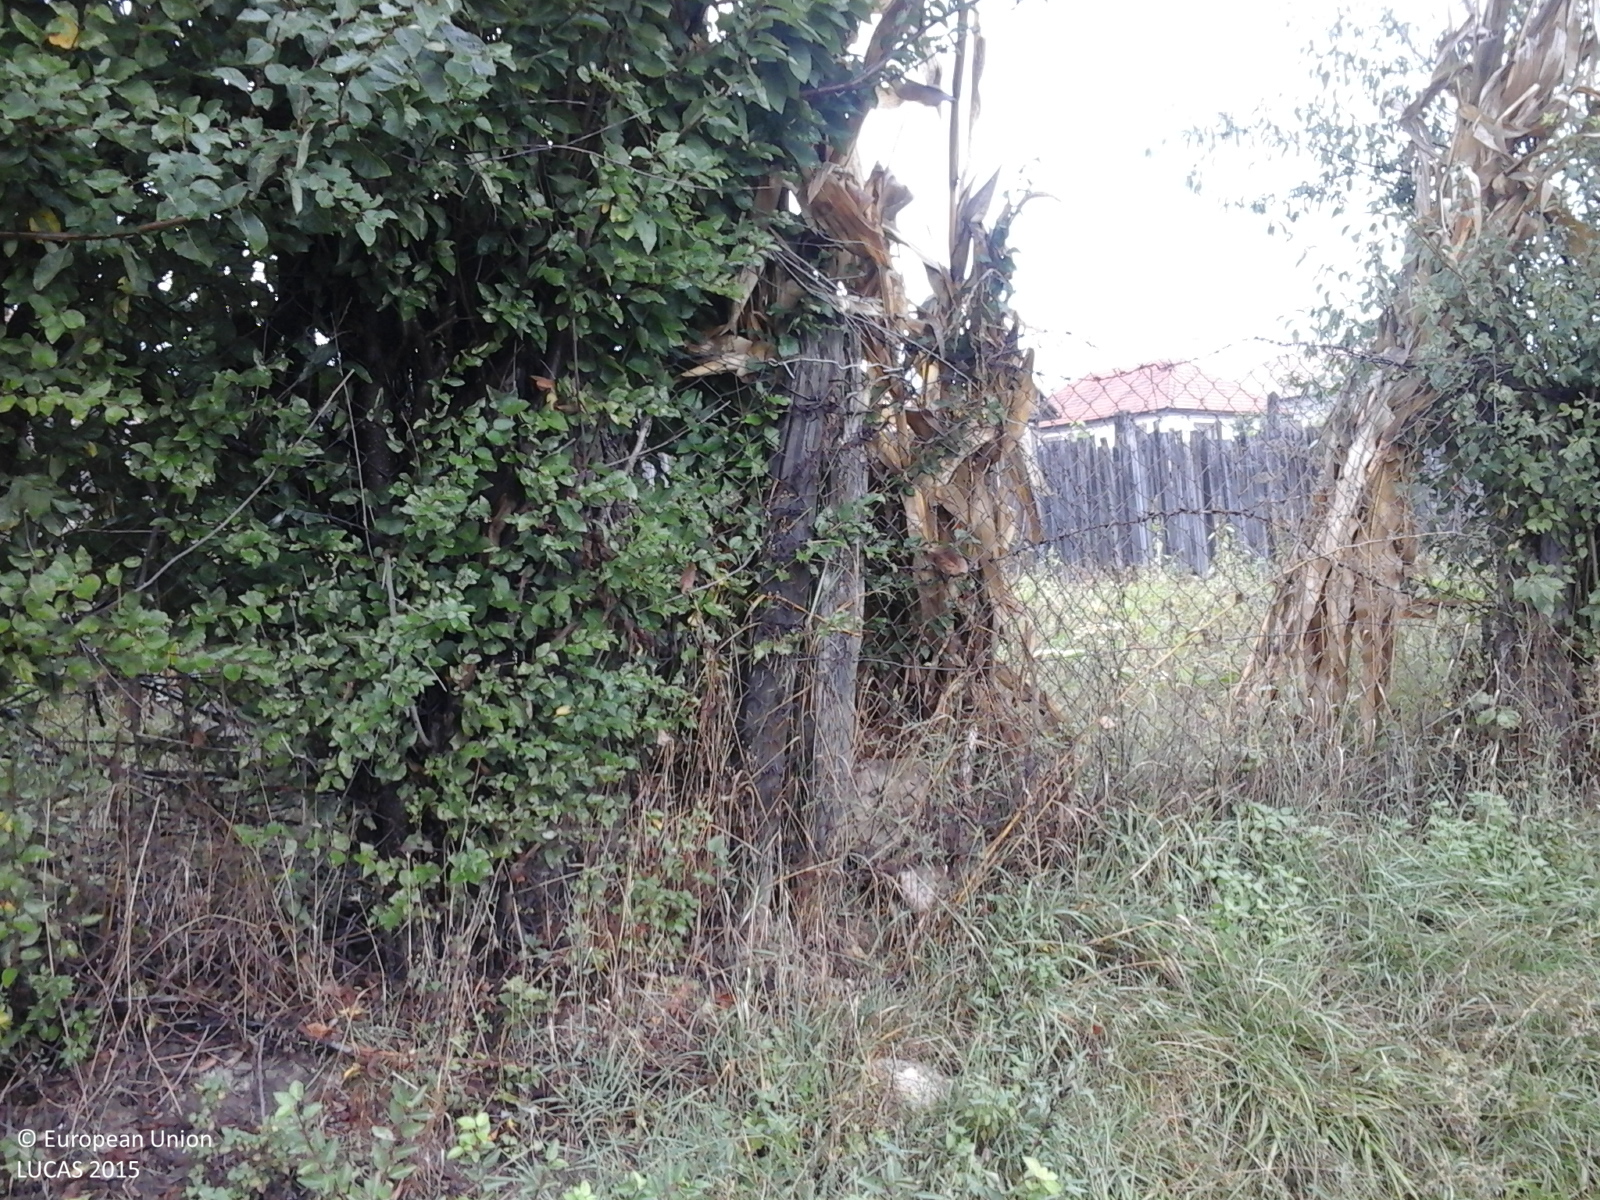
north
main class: Grassland
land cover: Grassland without tree/shrub cover
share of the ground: > 75 %
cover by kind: herbaceous plants 100 %
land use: Agriculture (excluding fallow land and kitchen gardens)
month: September
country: RO
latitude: 45.0488
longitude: 23.5293
